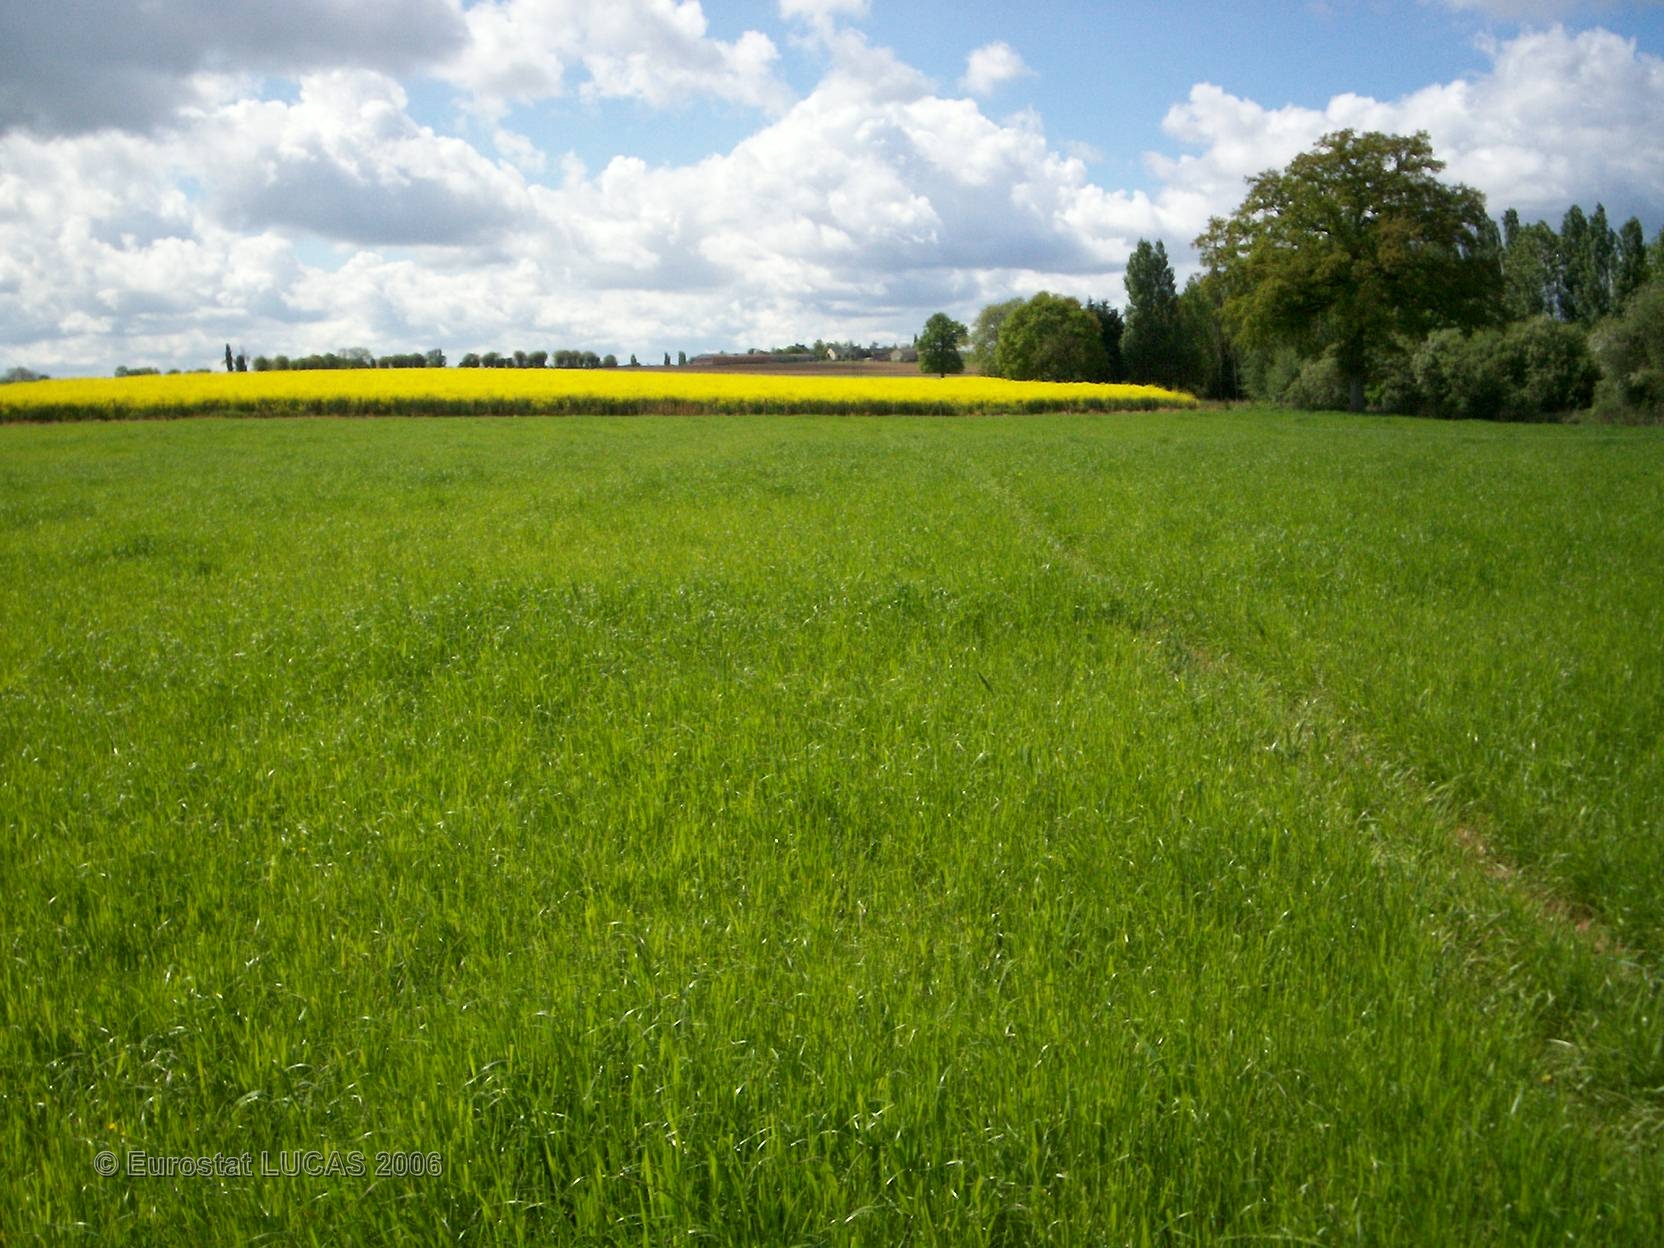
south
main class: Grassland
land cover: Grassland without tree/shrub cover
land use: Agriculture (excluding fallow land and kitchen gardens)
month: May
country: FR
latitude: 47.8971
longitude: -1.1016
